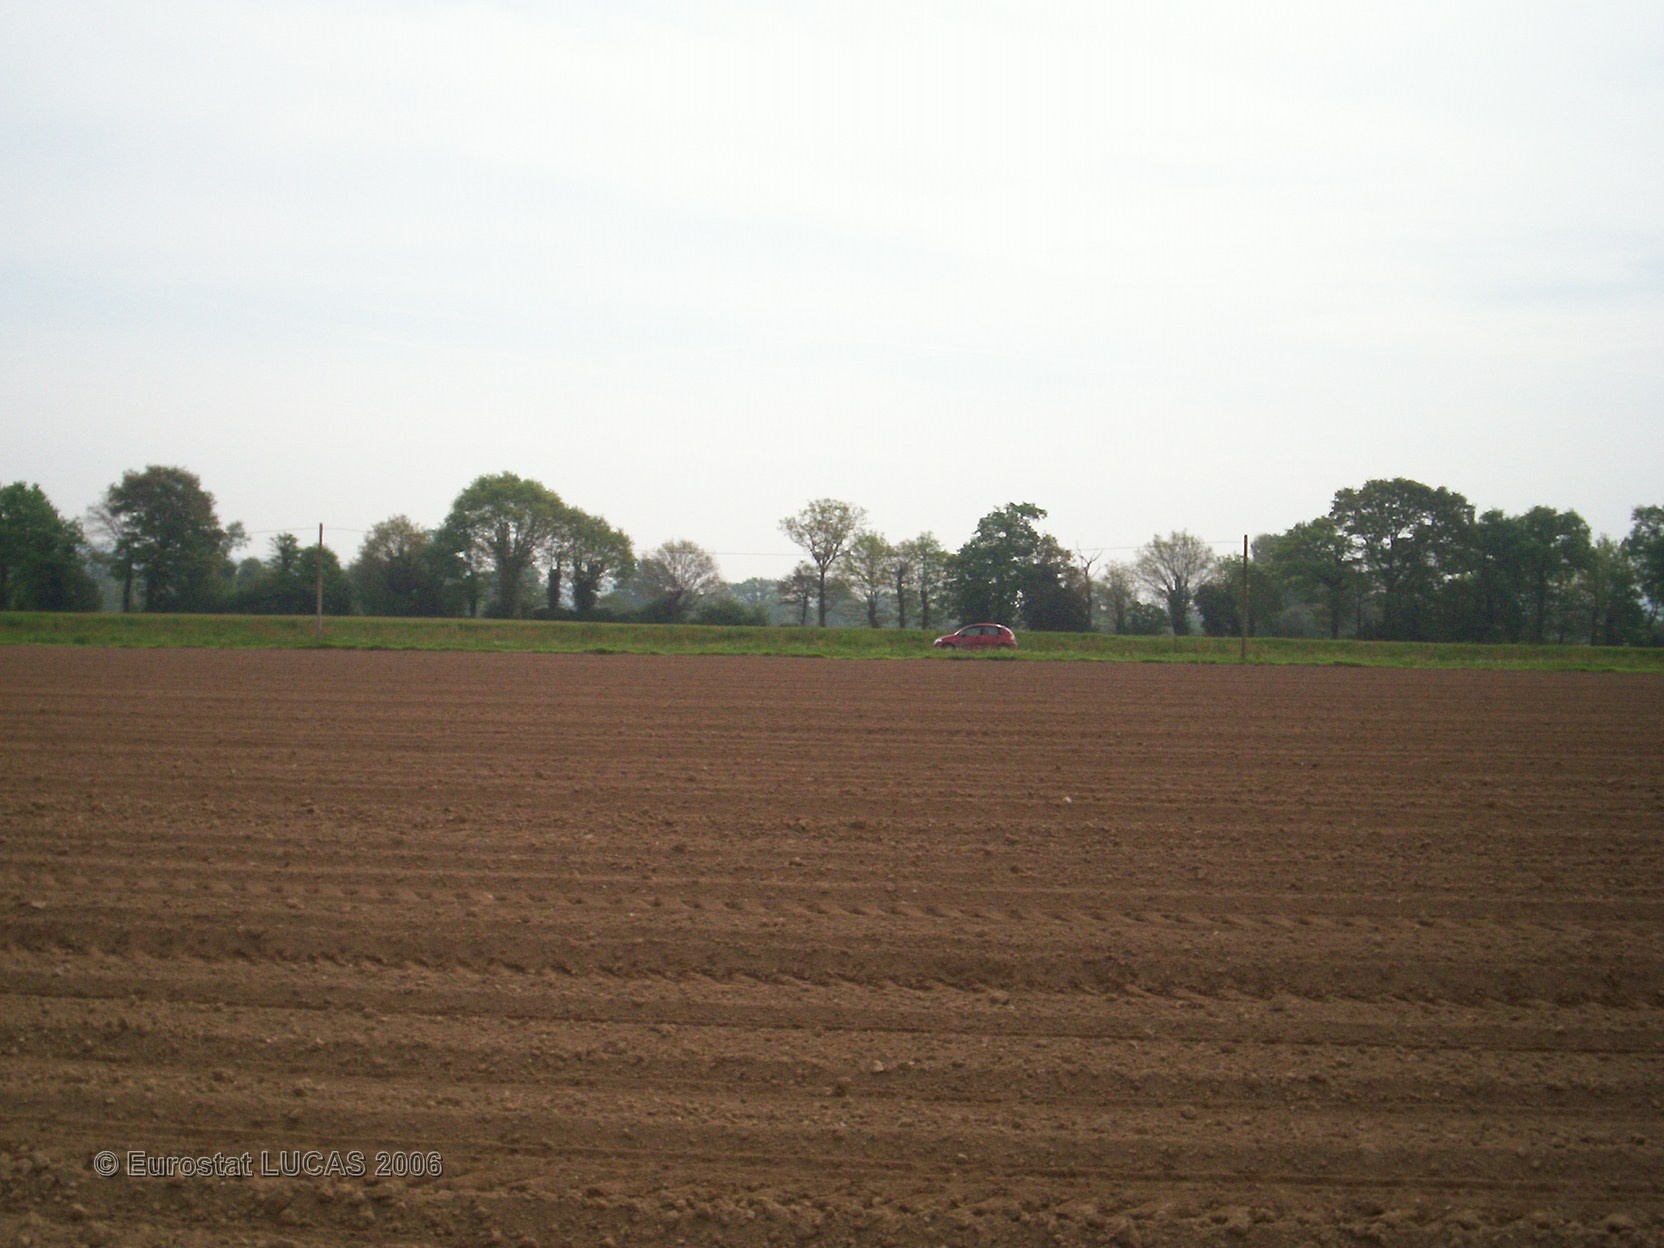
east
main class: Cropland
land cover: Maize
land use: Agriculture (excluding fallow land and kitchen gardens)
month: May
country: FR
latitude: 47.7633
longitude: -2.3438
